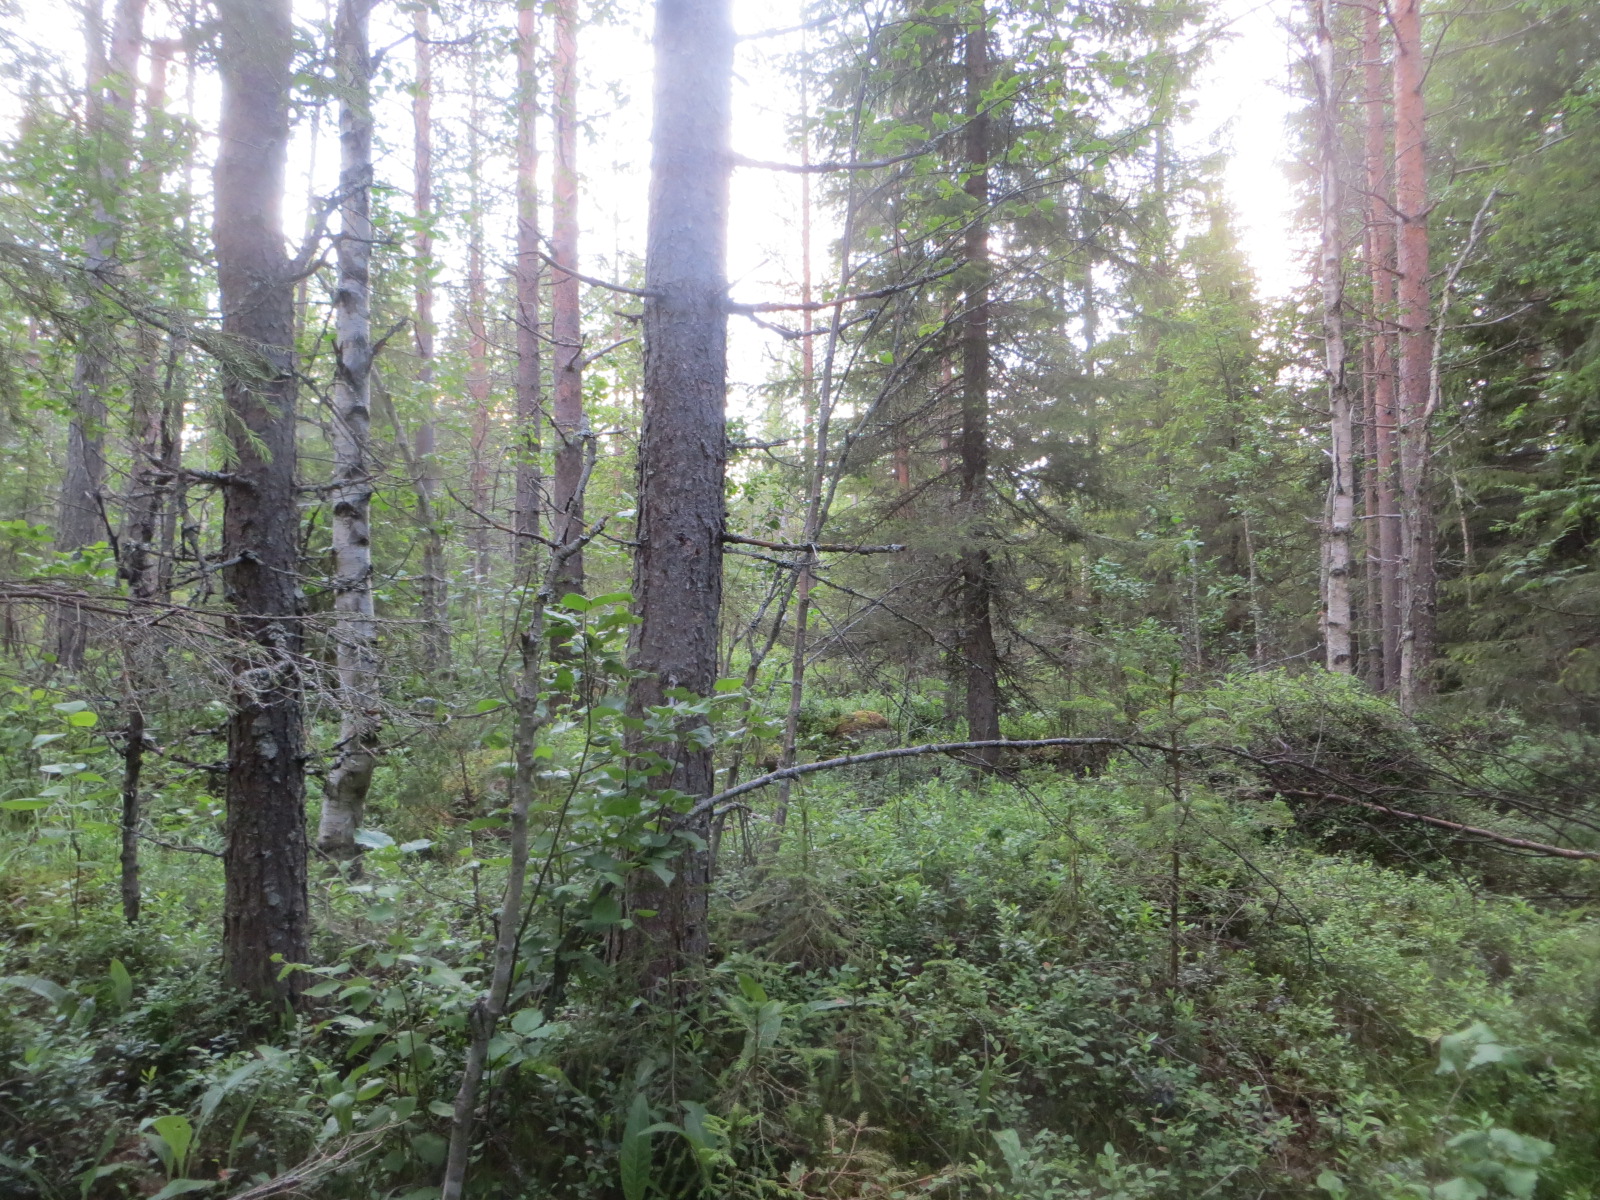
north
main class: Woodland
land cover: Other mixed woodland
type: boreal forest
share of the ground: 50 - 75 %
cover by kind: coniferous forest trees 40 %, broadleaved forest trees 30 %, shrubs 20 %, herbaceous plants 10 %
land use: Forestry
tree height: > 5 m
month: July
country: FI
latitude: 66.3127
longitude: 24.4791
